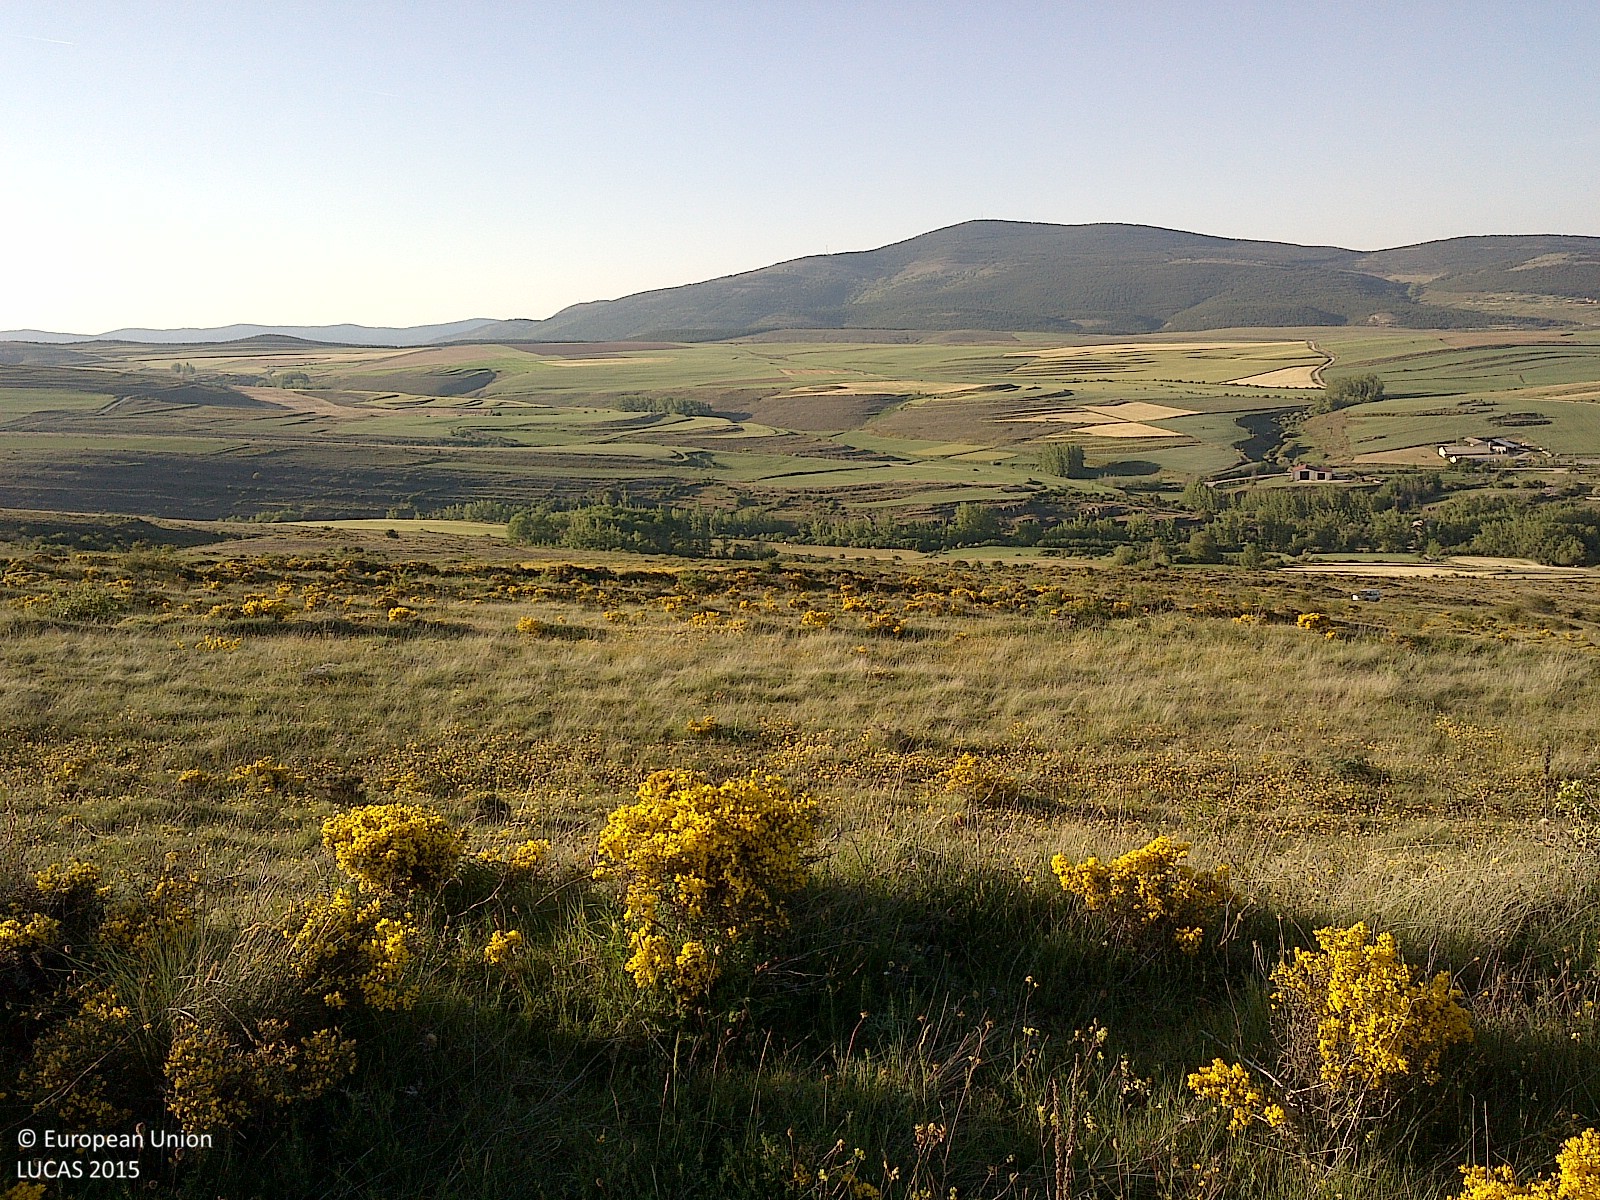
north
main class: Shrubland
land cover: Shrubland without tree cover
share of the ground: 50 - 75 %
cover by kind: shrubs 55 %, herbaceous plants 45 %
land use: Agriculture (excluding fallow land and kitchen gardens)
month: May
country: ES
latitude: 42.0114
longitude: -2.2946
